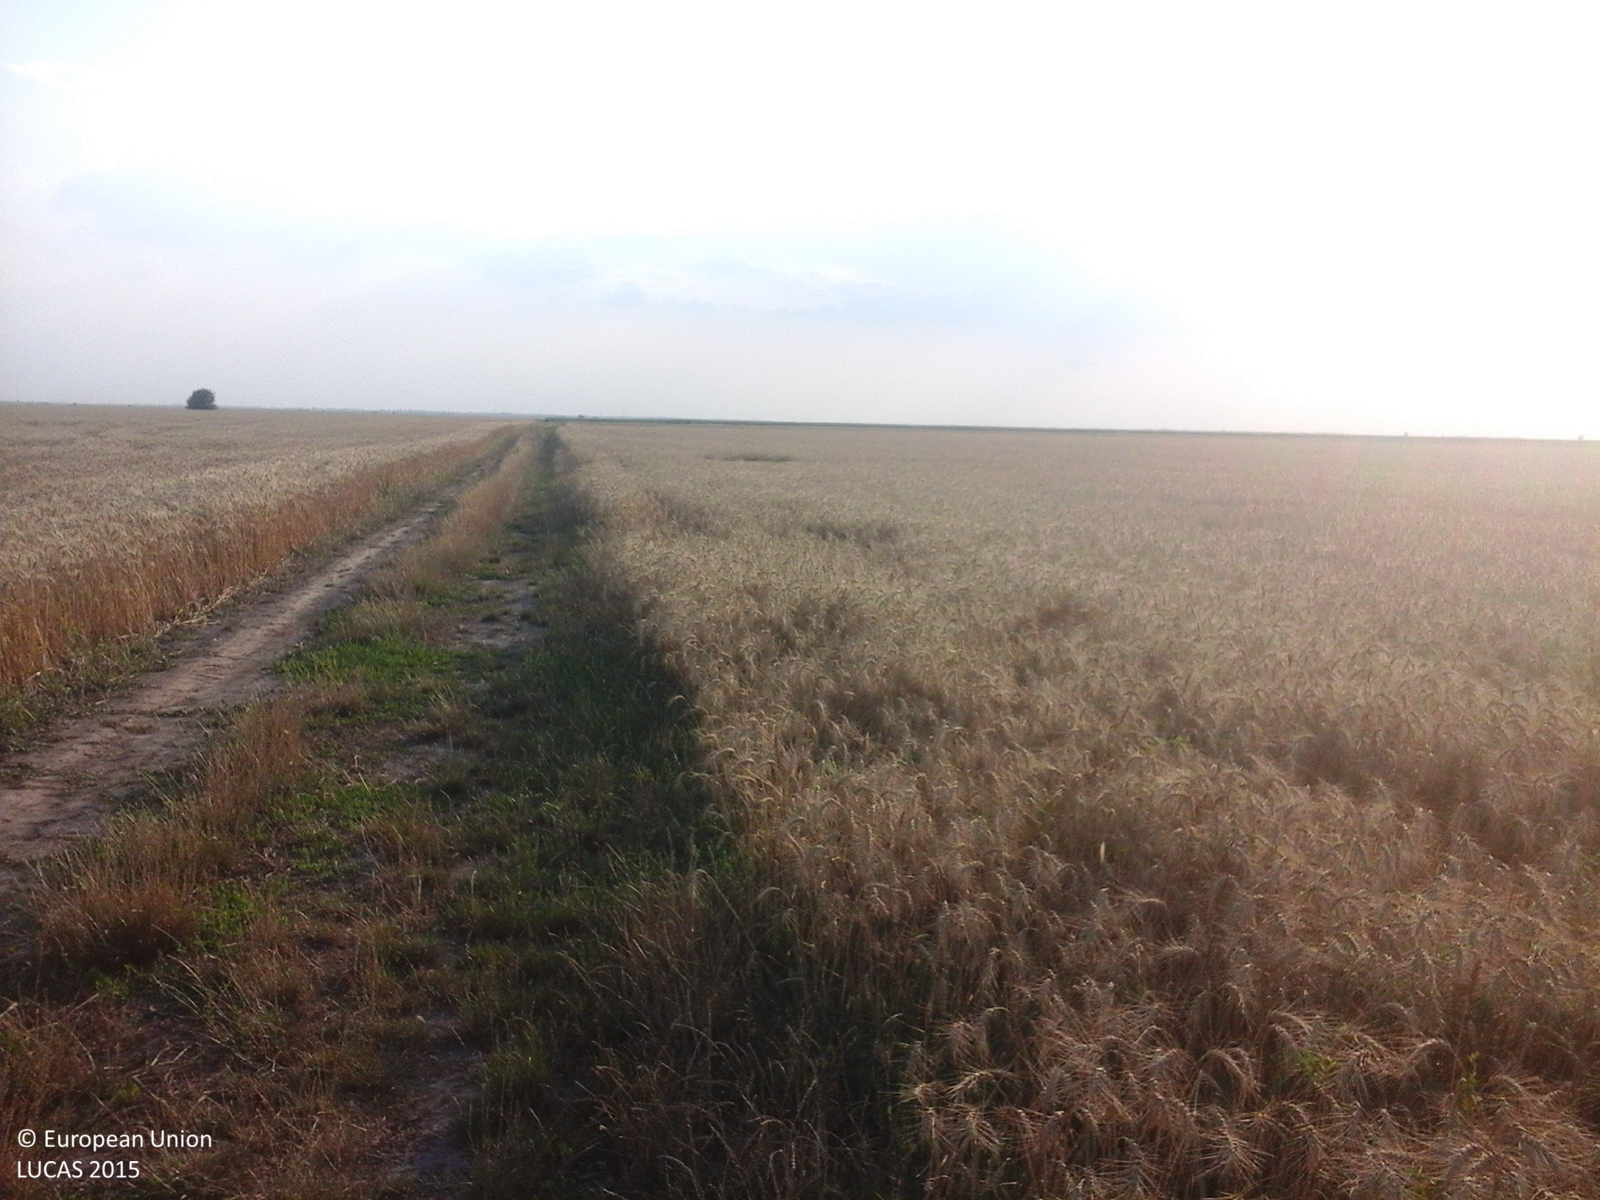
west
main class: Cropland
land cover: Common wheat
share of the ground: > 75 %
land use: Agriculture (excluding fallow land and kitchen gardens)
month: July
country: RO
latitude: 43.9261
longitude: 24.7810
